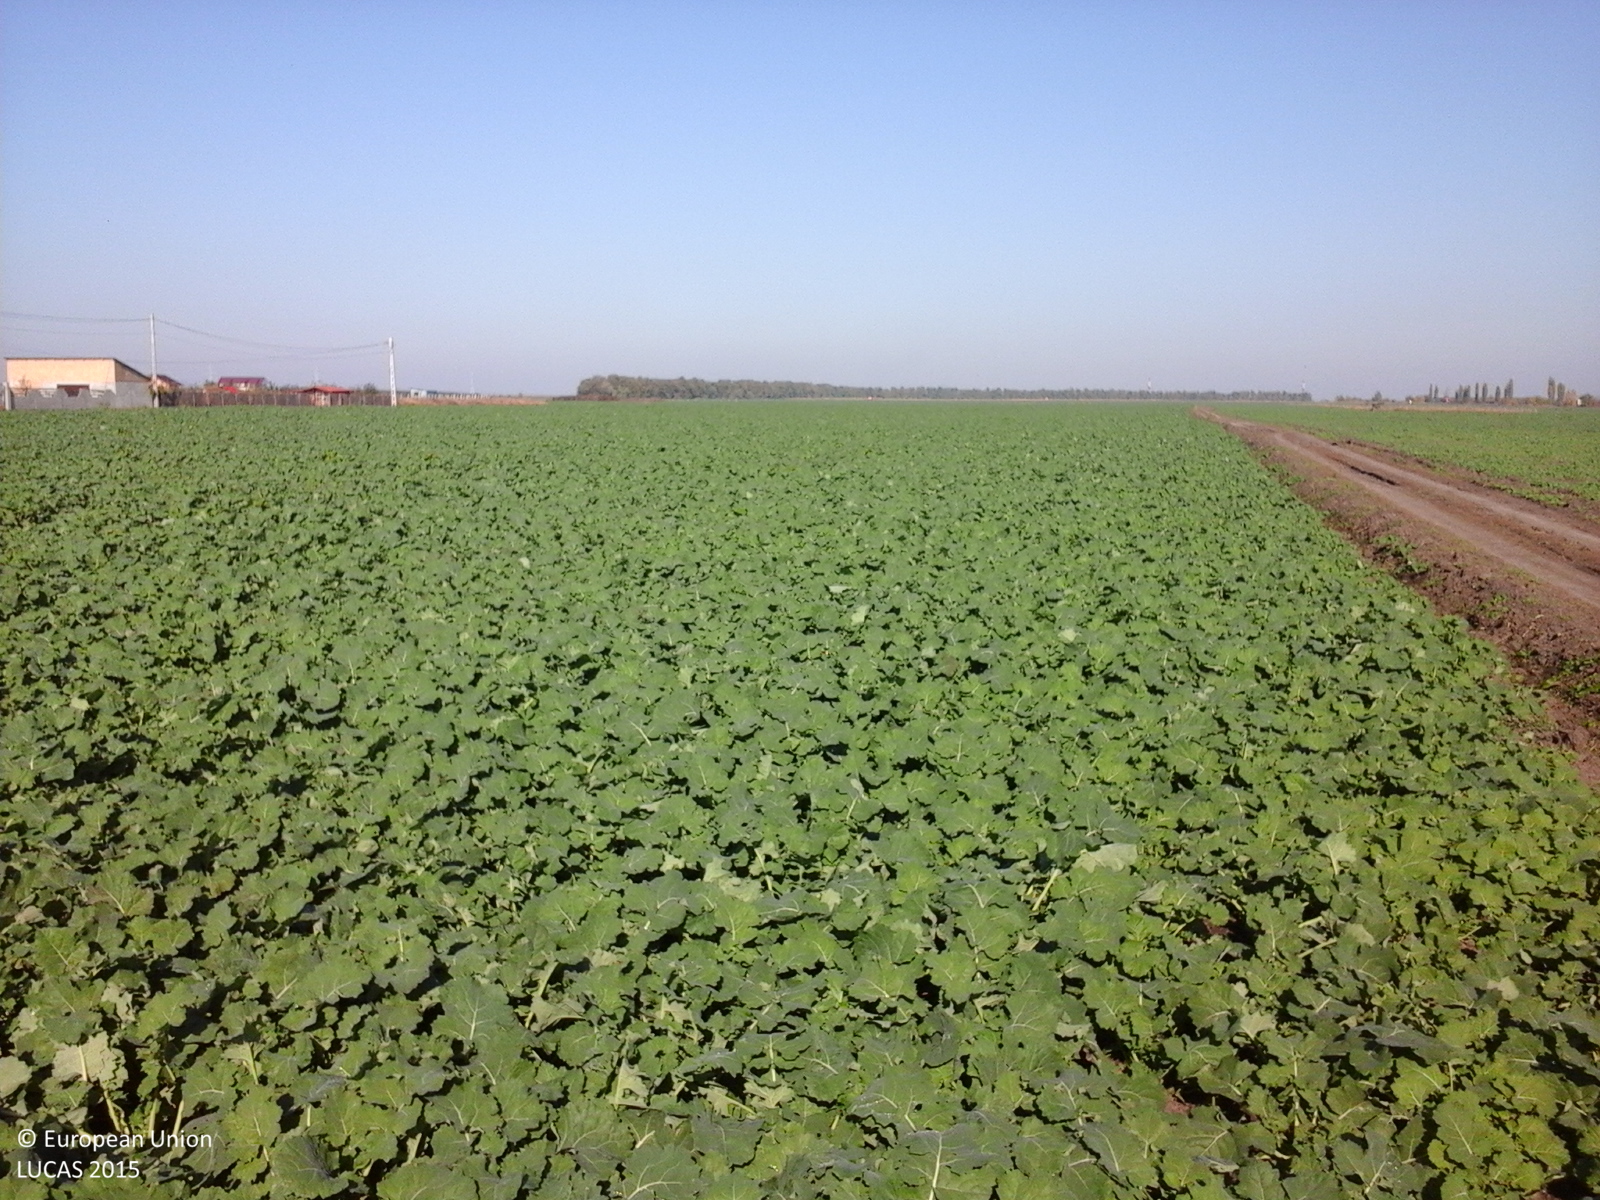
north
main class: Cropland
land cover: Rape and turnip rape
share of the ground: > 75 %
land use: Agriculture (excluding fallow land and kitchen gardens)
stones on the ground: < 10 %
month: October
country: RO
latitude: 45.7180
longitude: 27.1951
